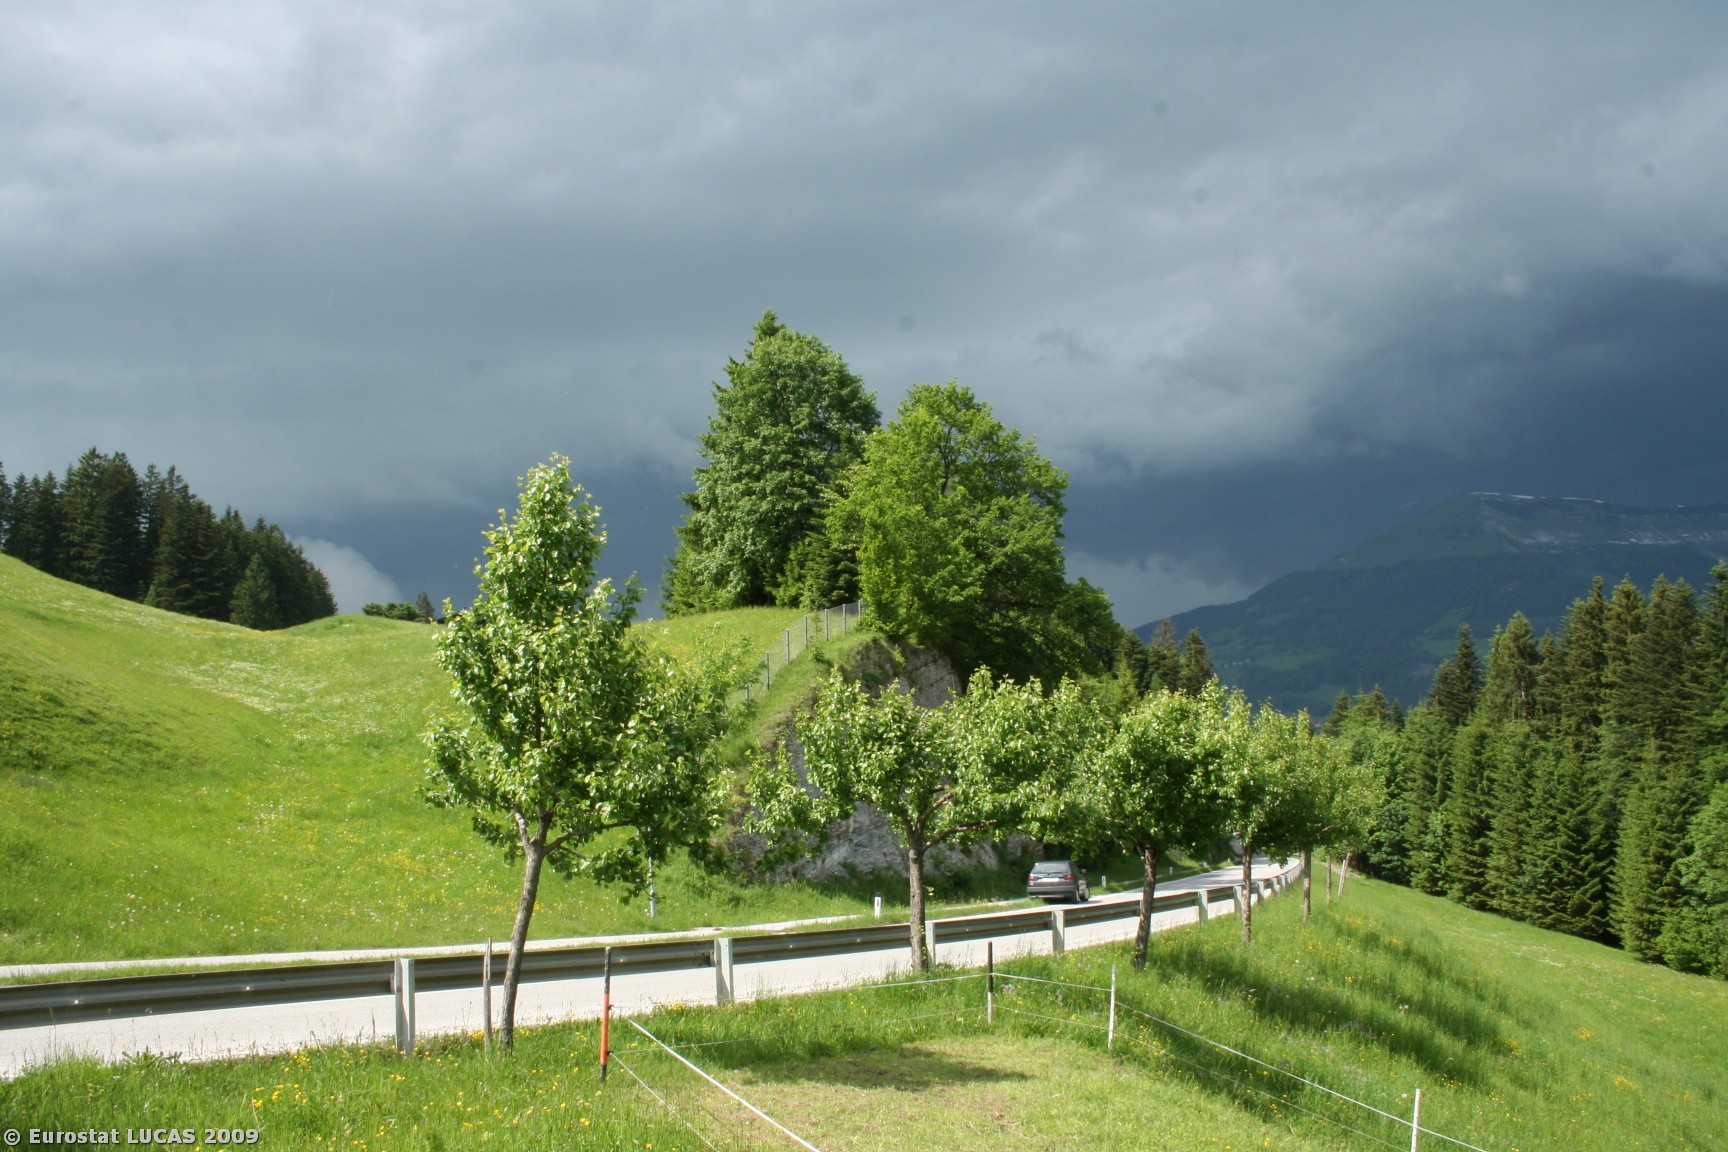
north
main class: Grassland
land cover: Grassland without tree/shrub cover
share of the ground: > 75 %
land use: Agriculture (excluding fallow land and kitchen gardens)
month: May
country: AT
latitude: 47.6366
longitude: 13.2061
